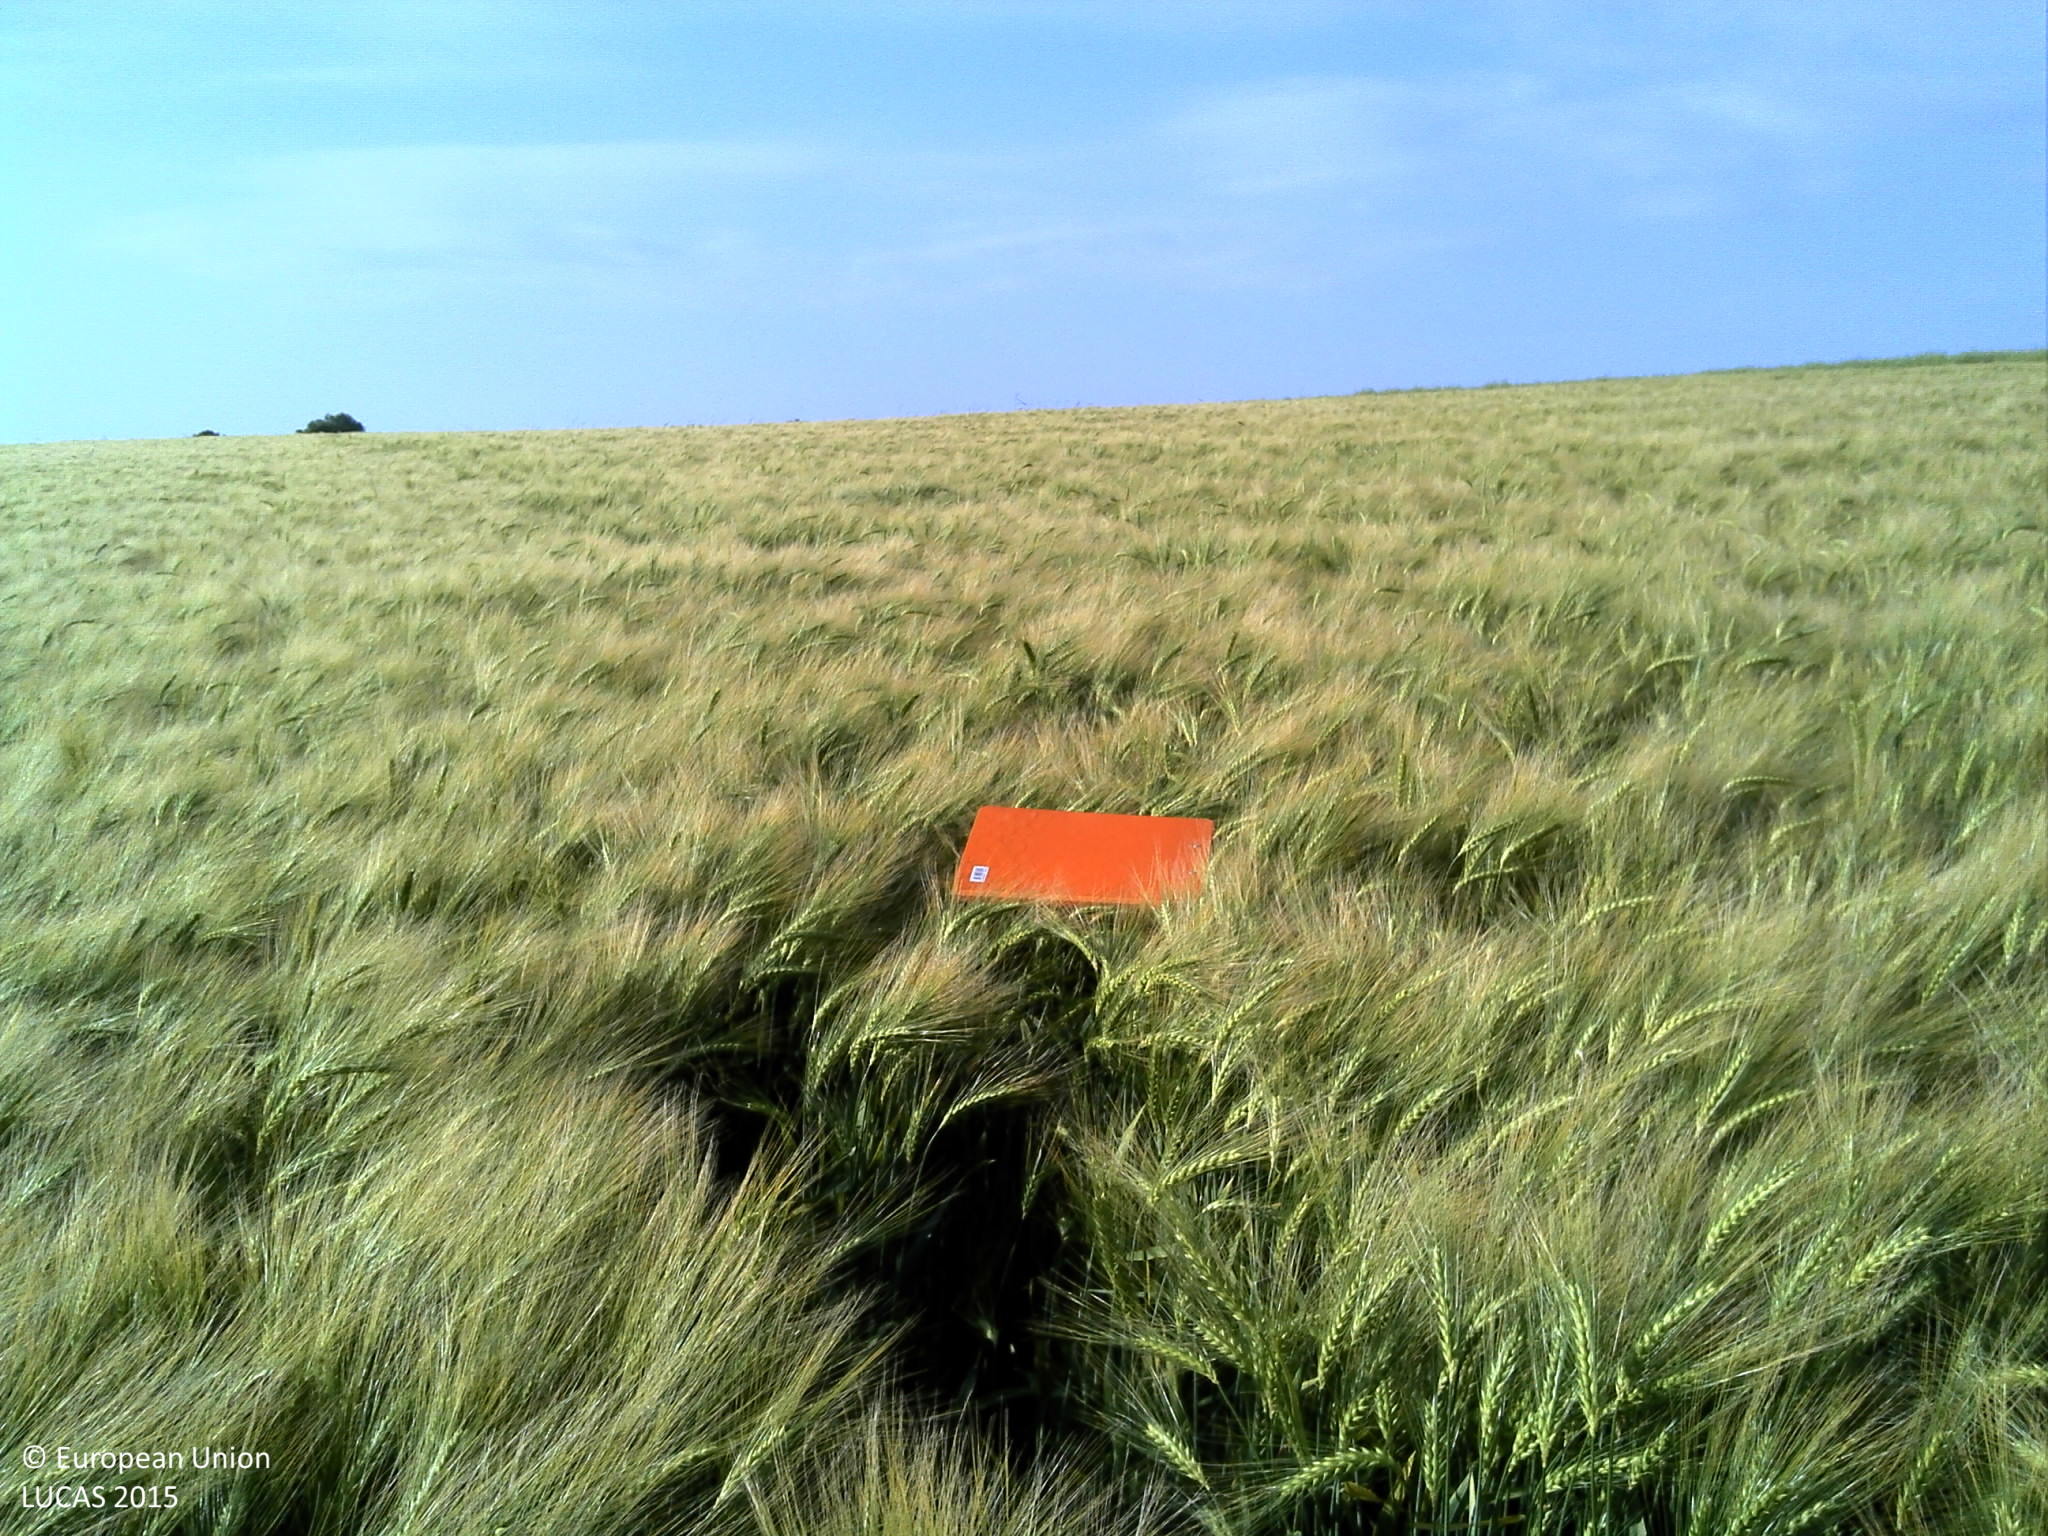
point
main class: Cropland
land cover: Barley
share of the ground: > 75 %
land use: Agriculture (excluding fallow land and kitchen gardens)
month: June
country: FR
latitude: 49.6903
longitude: 1.0927
